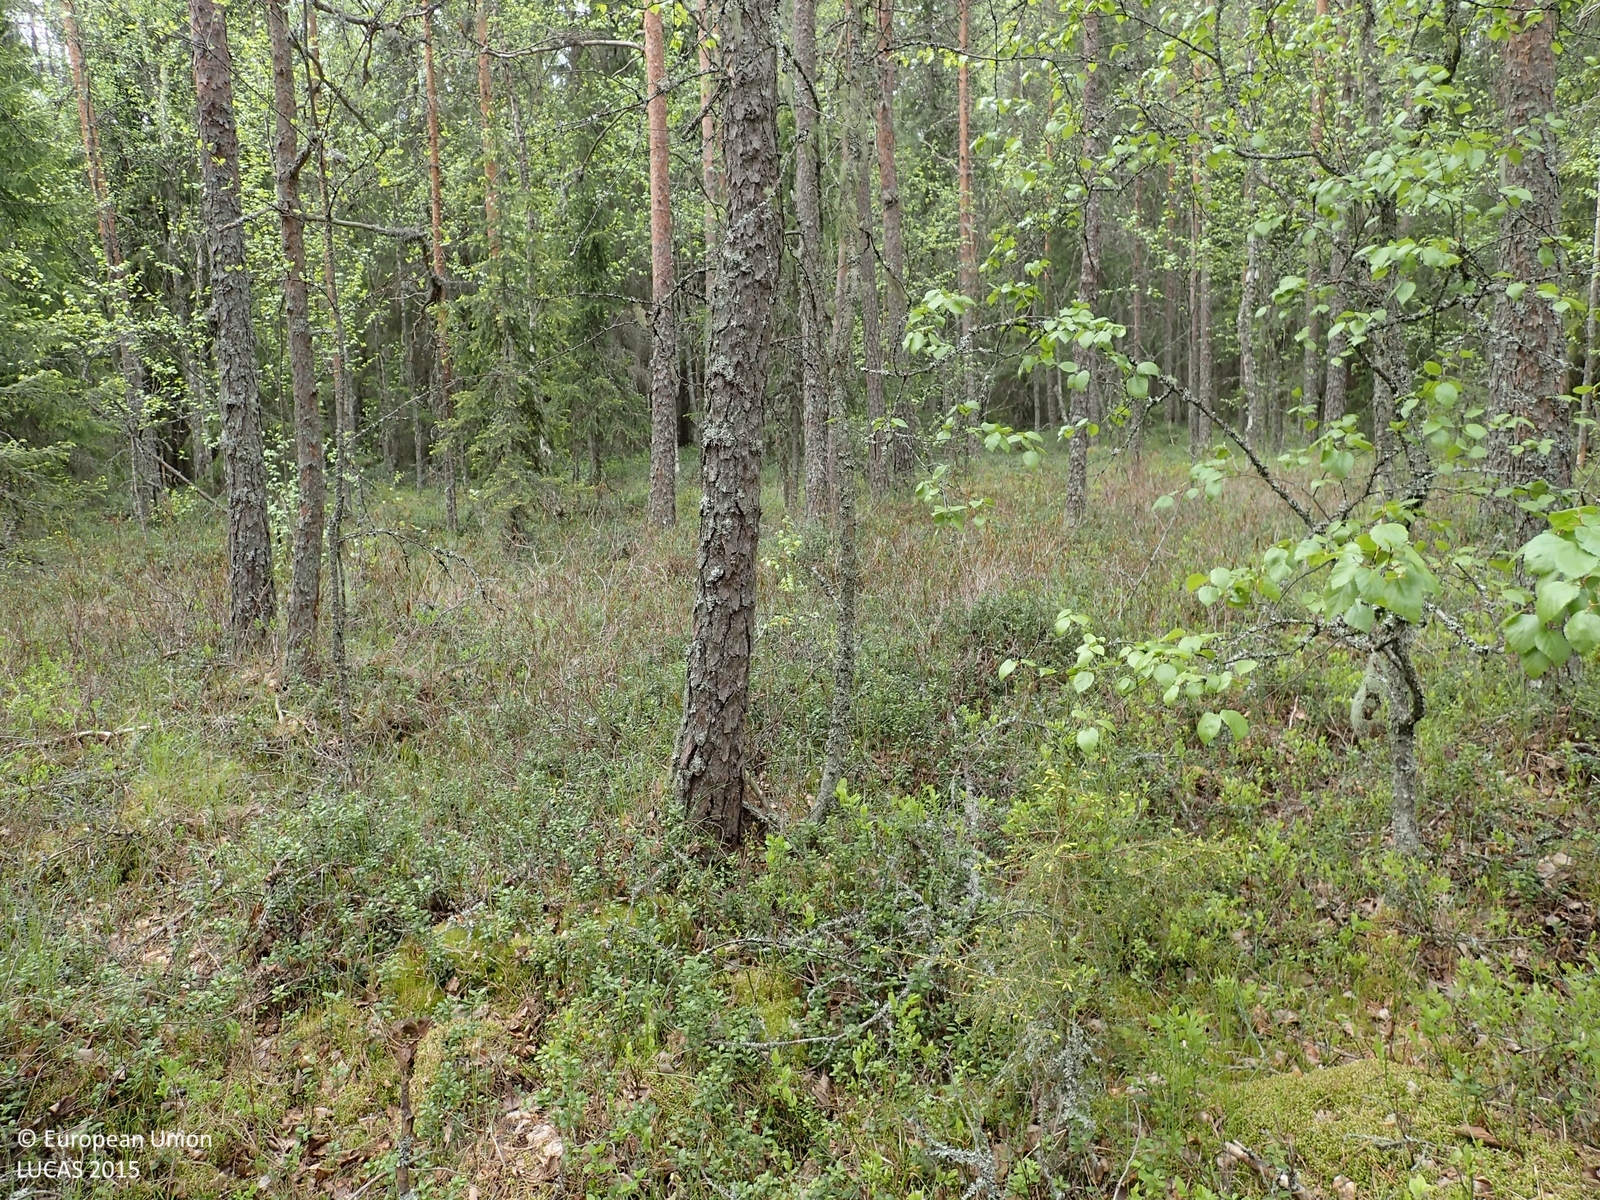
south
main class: Woodland
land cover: Pine dominated mixed woodland
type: boreal forest
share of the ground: > 75 %
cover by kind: coniferous forest trees 65 %, broadleaved forest trees 25 %, shrubs 10 %
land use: Forestry
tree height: > 5 m
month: June
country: FI
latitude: 62.2435
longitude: 21.7311
